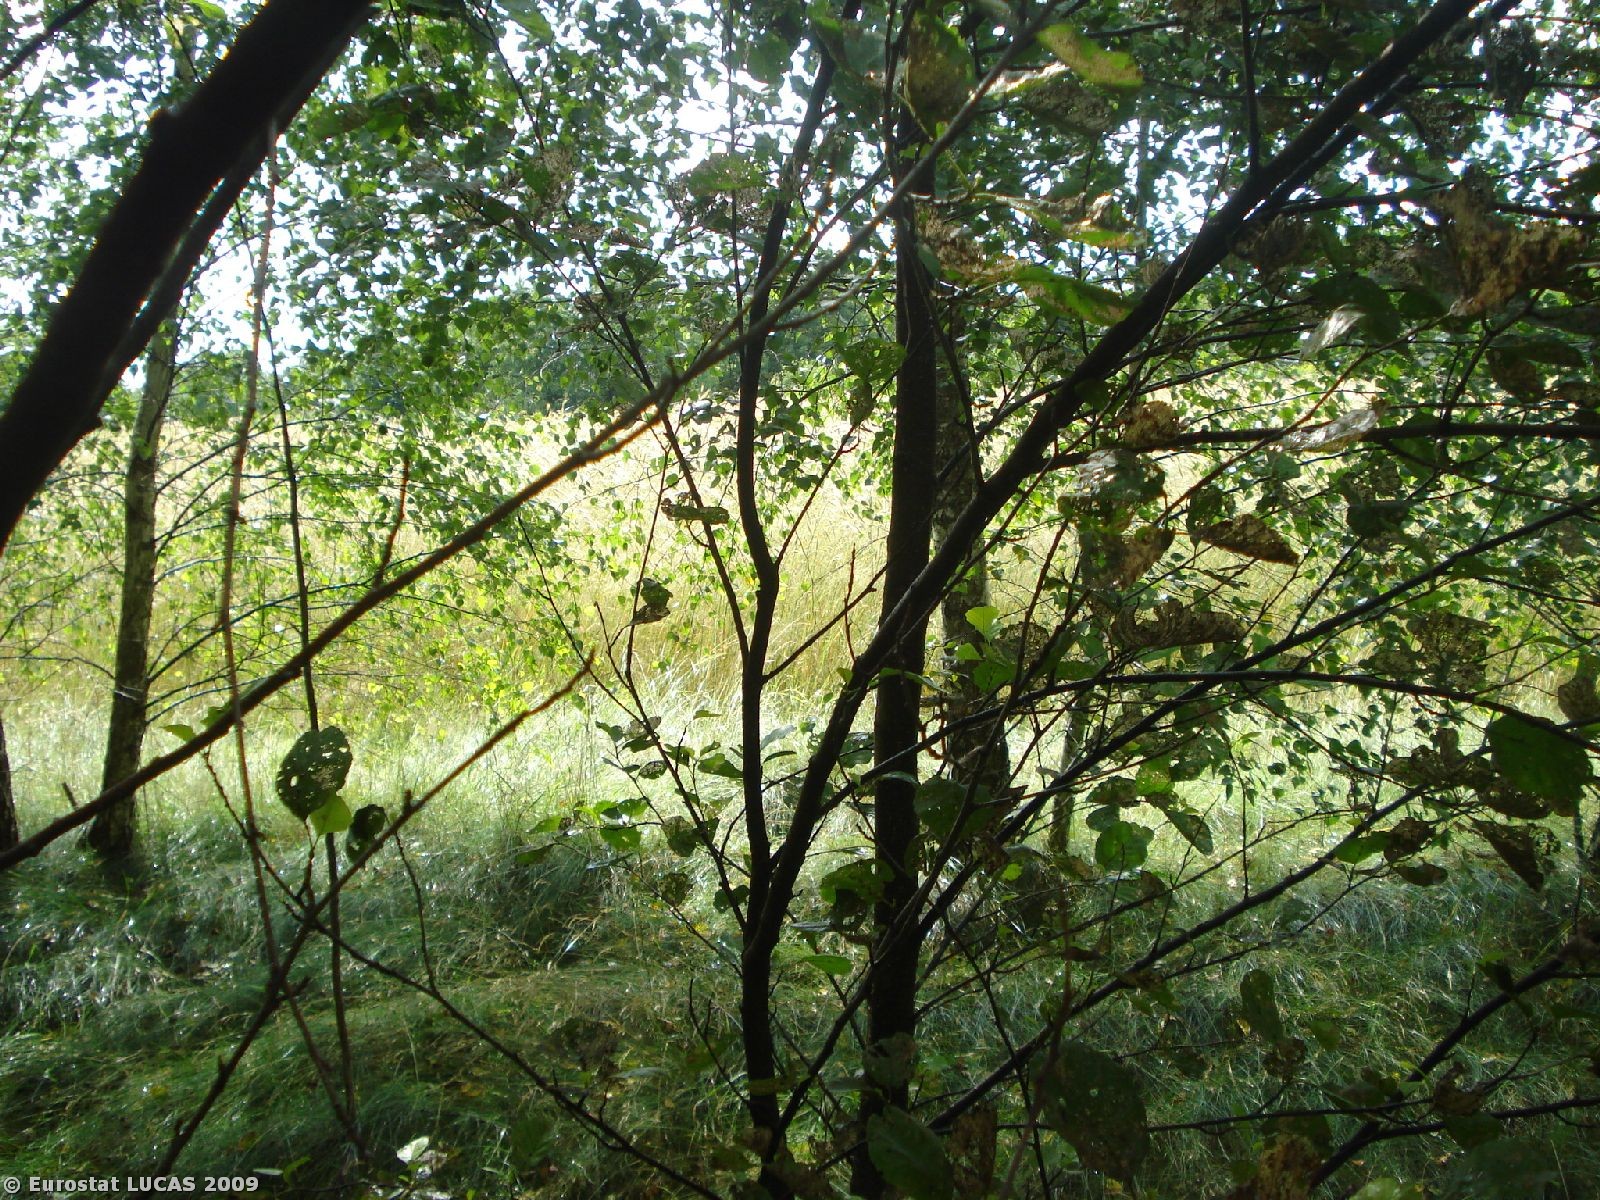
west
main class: Woodland
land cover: Broadleaved woodland
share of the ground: 50 - 75 %
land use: Agriculture (excluding fallow land and kitchen gardens)
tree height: > 5 m
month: July
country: PL
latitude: 51.3236
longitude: 23.0630
